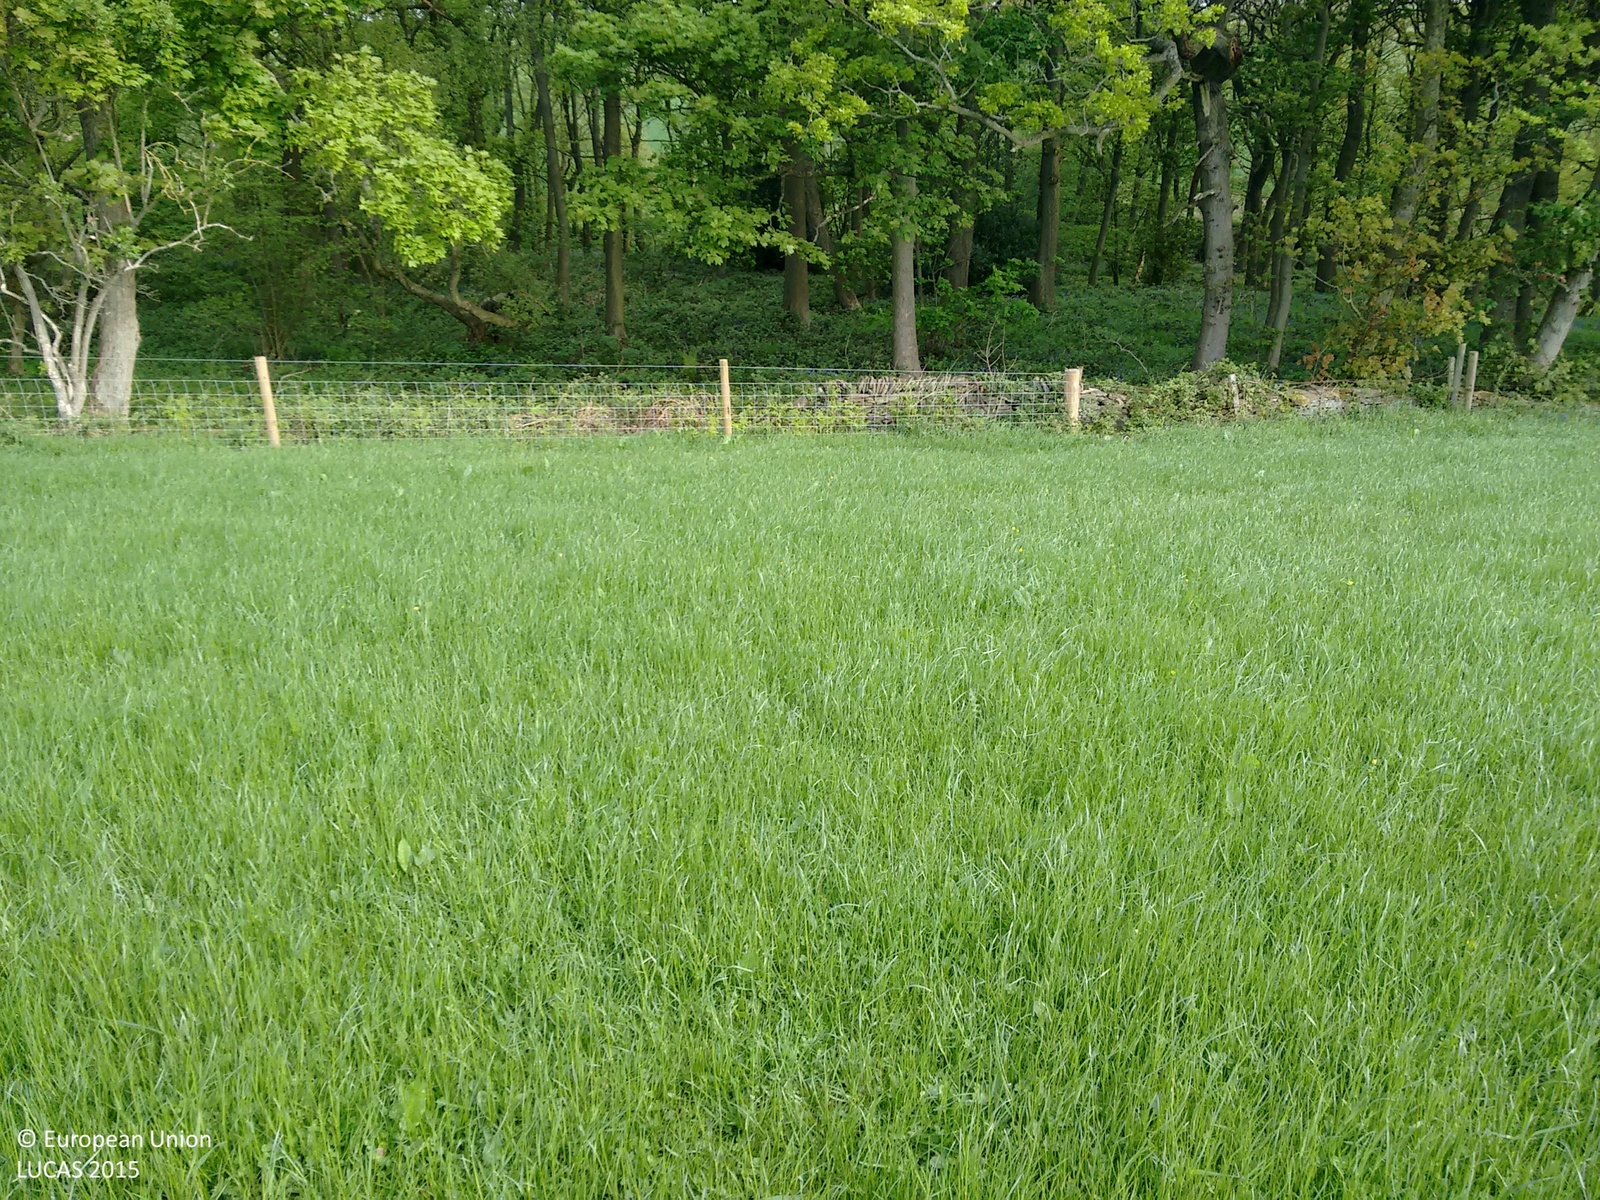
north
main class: Grassland
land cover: Grassland without tree/shrub cover
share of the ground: > 75 %
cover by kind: herbaceous plants 100 %
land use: Agriculture (excluding fallow land and kitchen gardens)
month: May
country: GB
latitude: 53.5985
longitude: -1.6724
